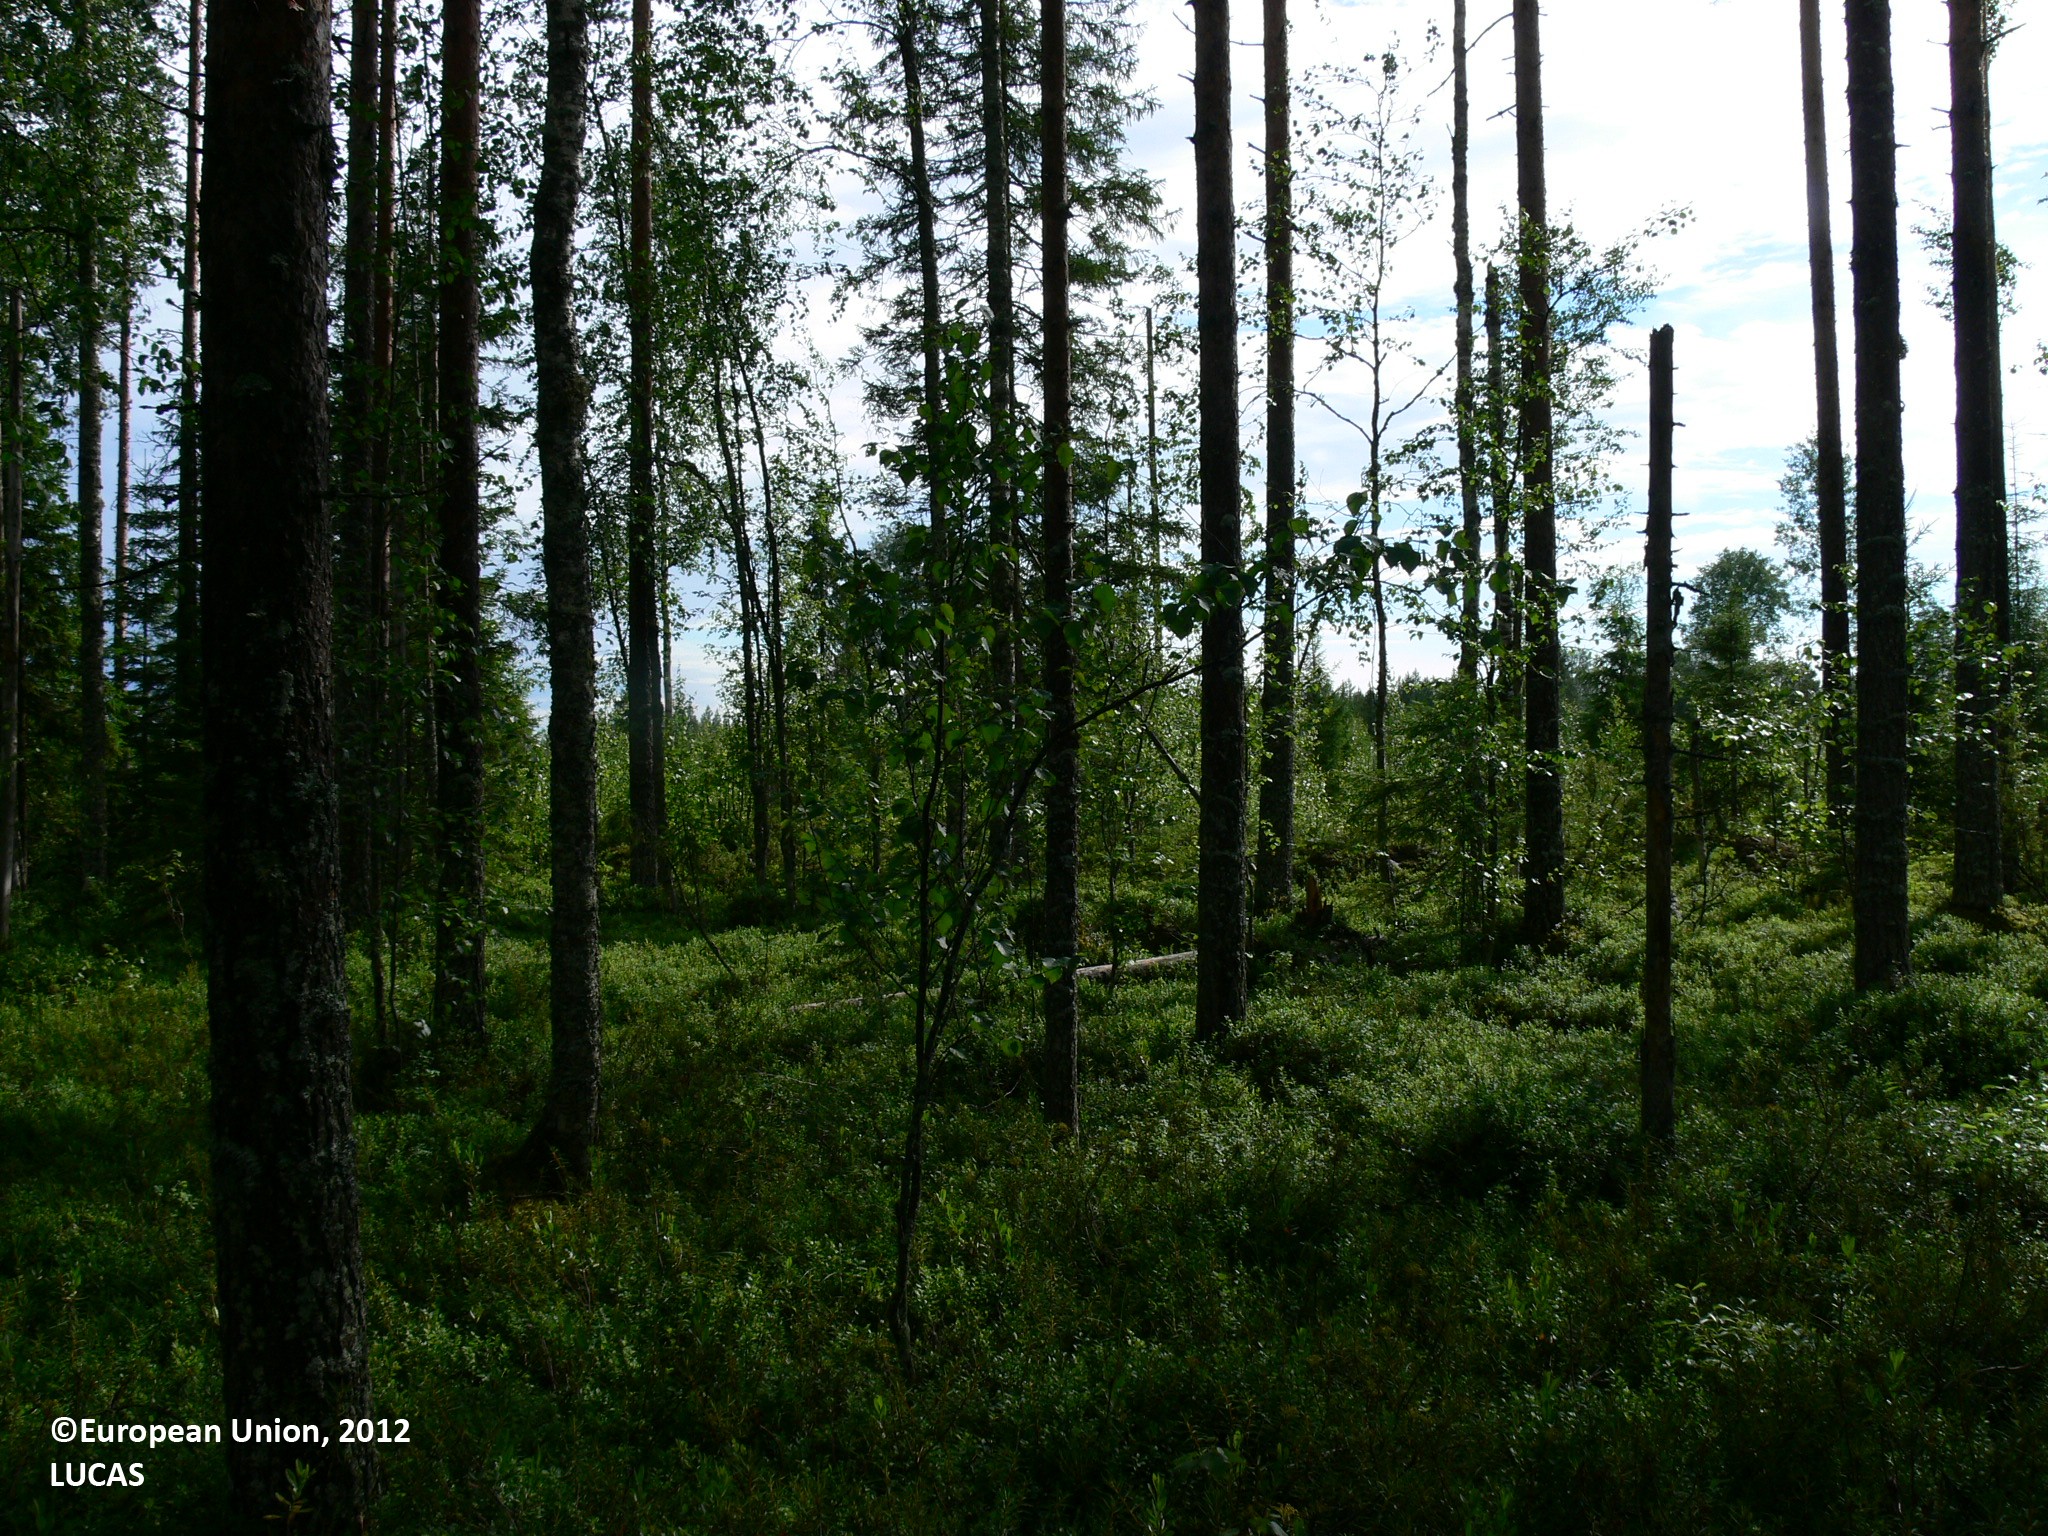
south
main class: Woodland
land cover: Pine dominated mixed woodland
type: boreal forest
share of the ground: 50 - 75 %
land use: Forestry
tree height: > 5 m
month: July
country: FI
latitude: 63.0602
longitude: 29.3174
